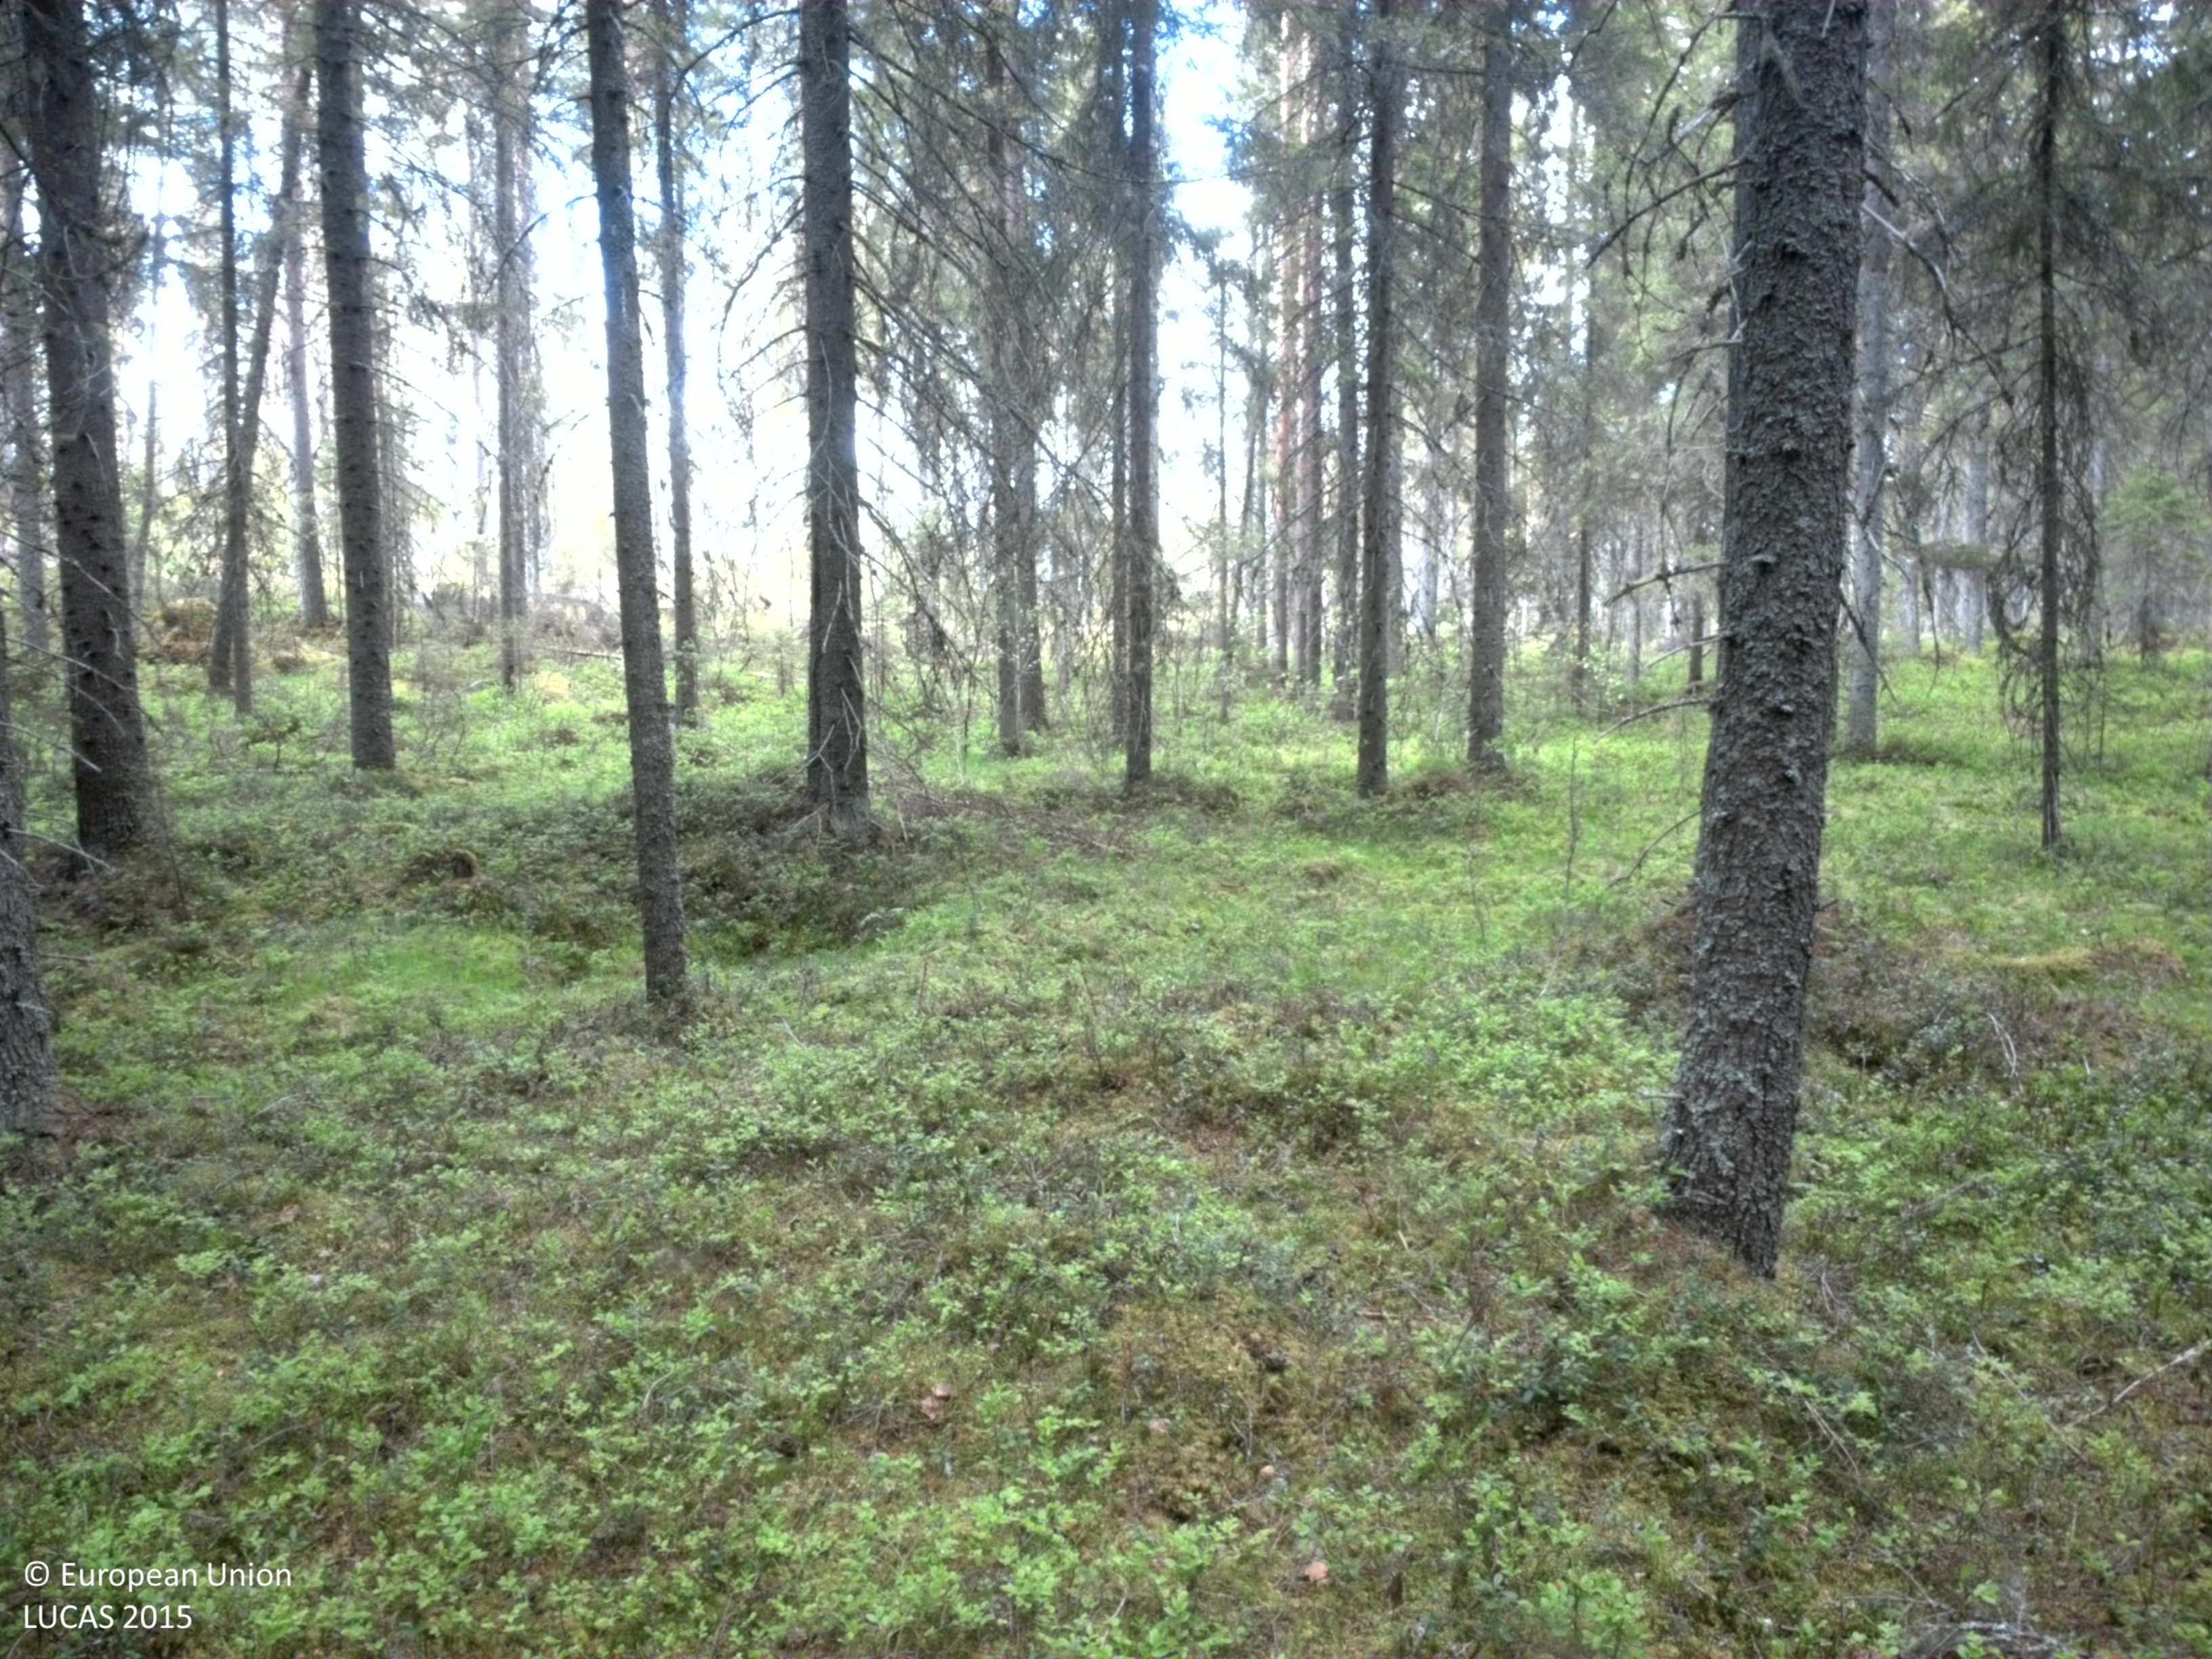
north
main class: Woodland
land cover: Spruce dominated coniferous woodland
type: boreal forest
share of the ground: > 75 %
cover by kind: coniferous forest trees 80 %, shrubs 15 %, lichens and mosses 5 %
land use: Forestry
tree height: > 5 m
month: June
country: SE
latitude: 64.0197
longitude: 20.3953
